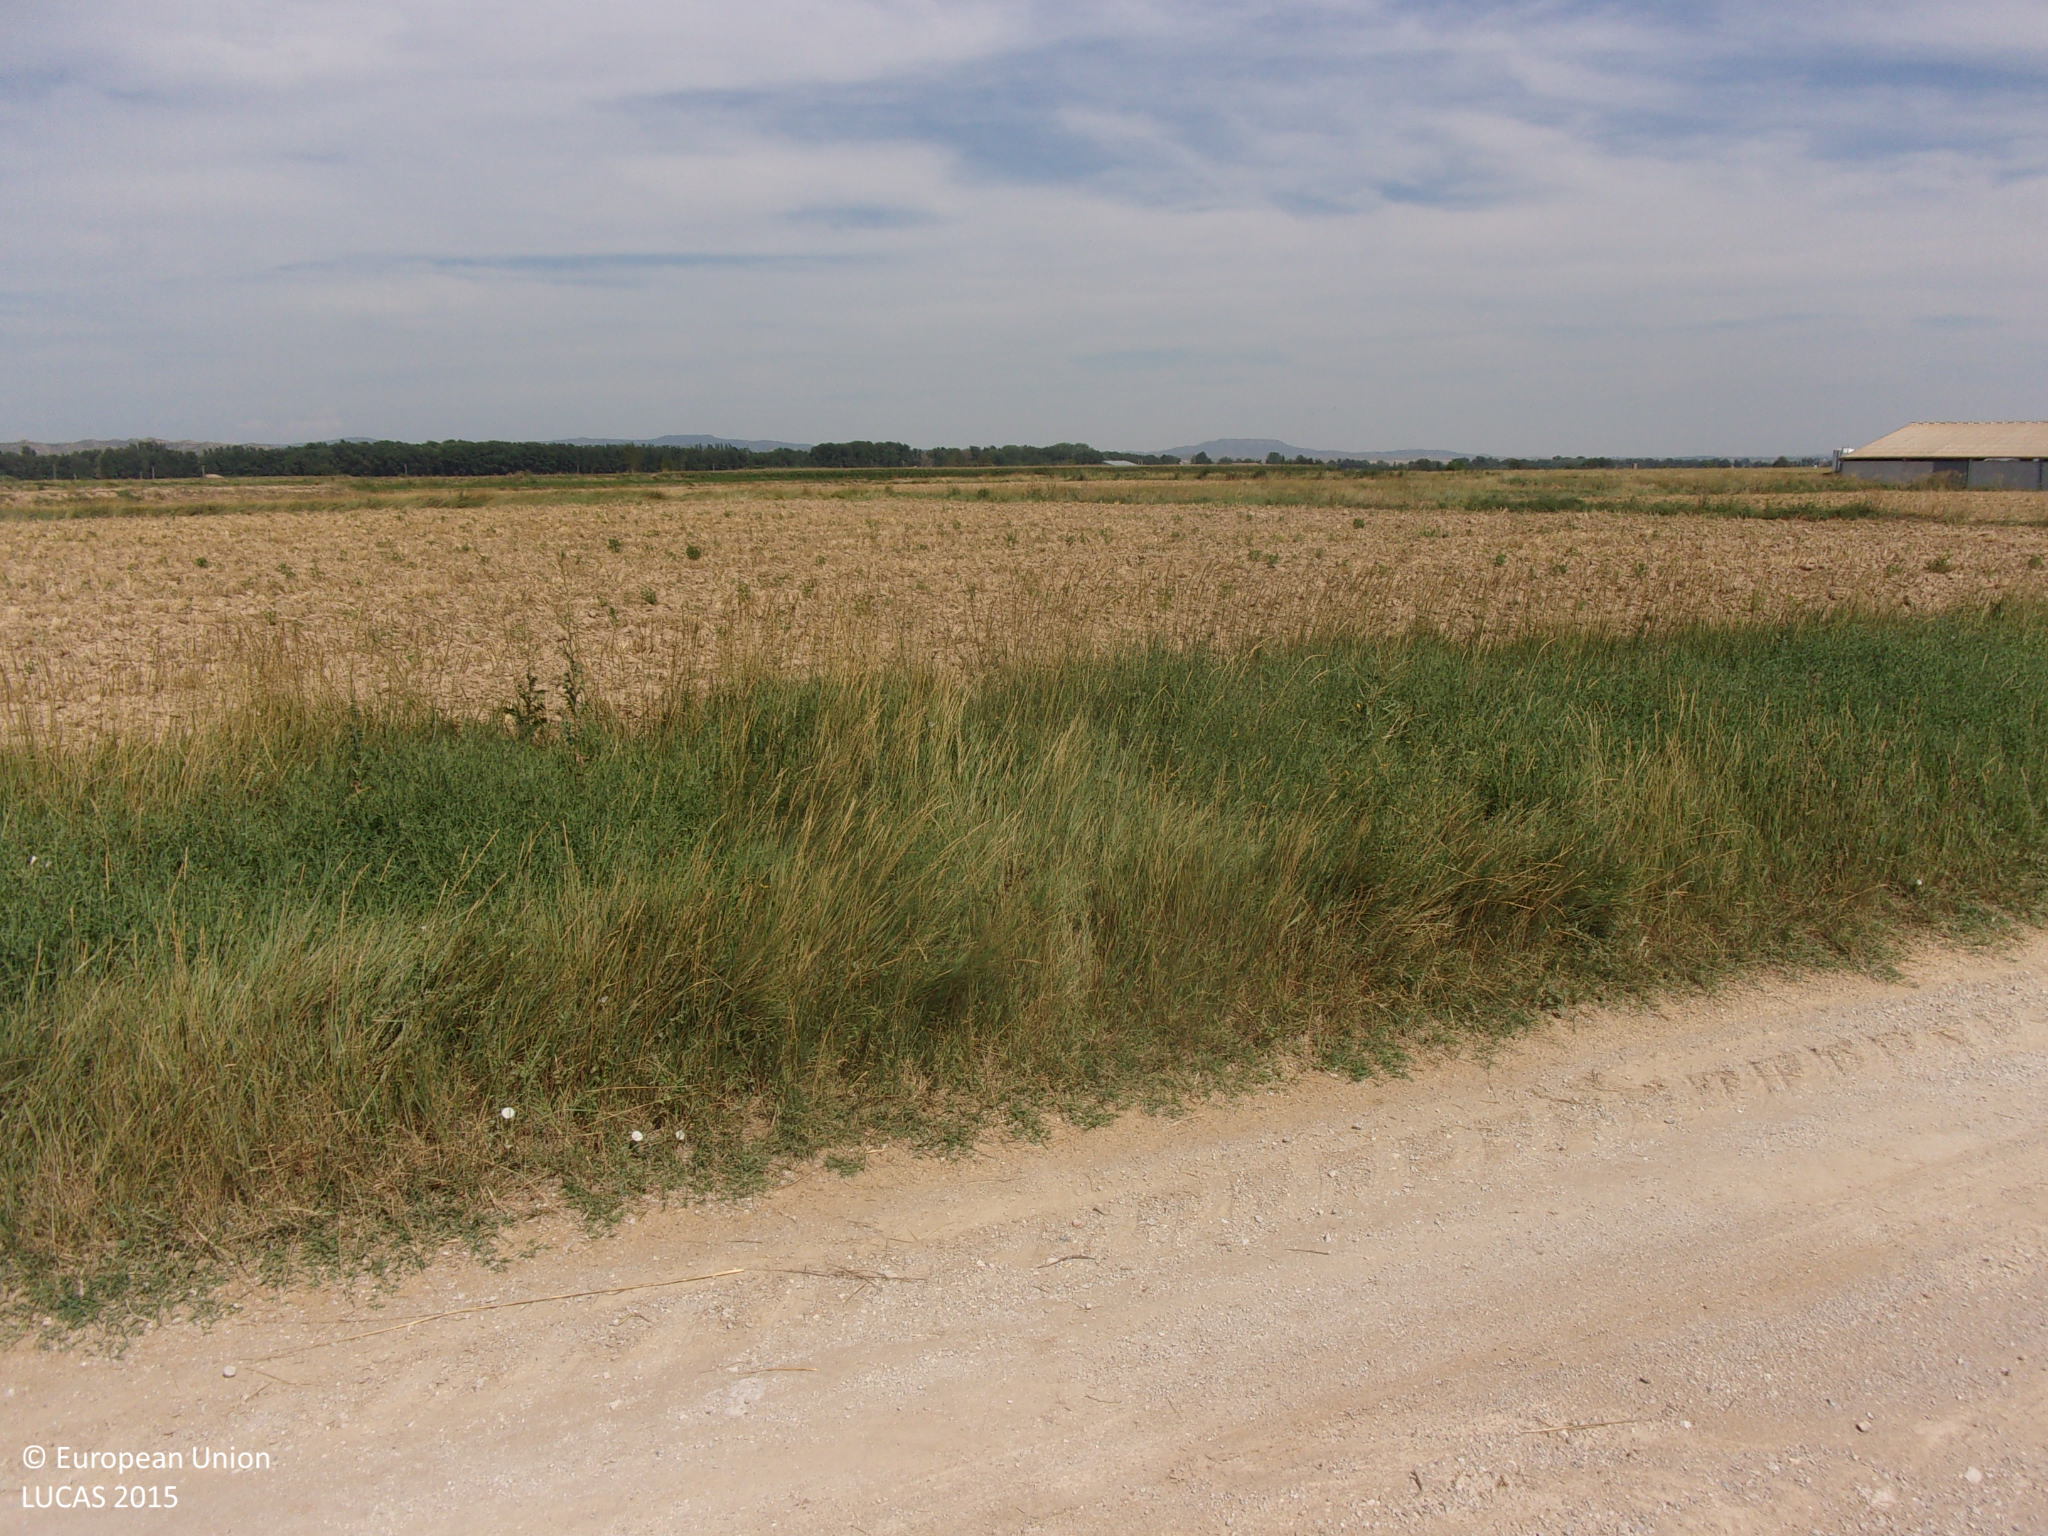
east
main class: Cropland
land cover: Barley
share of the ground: < 10 %
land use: Agriculture (excluding fallow land and kitchen gardens)
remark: Harvested field
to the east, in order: Grass margins; Tracks; Grass margins; Barley; Grass margins; Barley; Grass margins; Ditches and canals; Grass margins; Barley; Grass margins; Barley; Grass margins; Ditches and canals; Grass margins; Tracks; Grass margins; Spontaneously vegetated surfaces
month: August
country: ES
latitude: 42.1637
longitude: -1.1521
